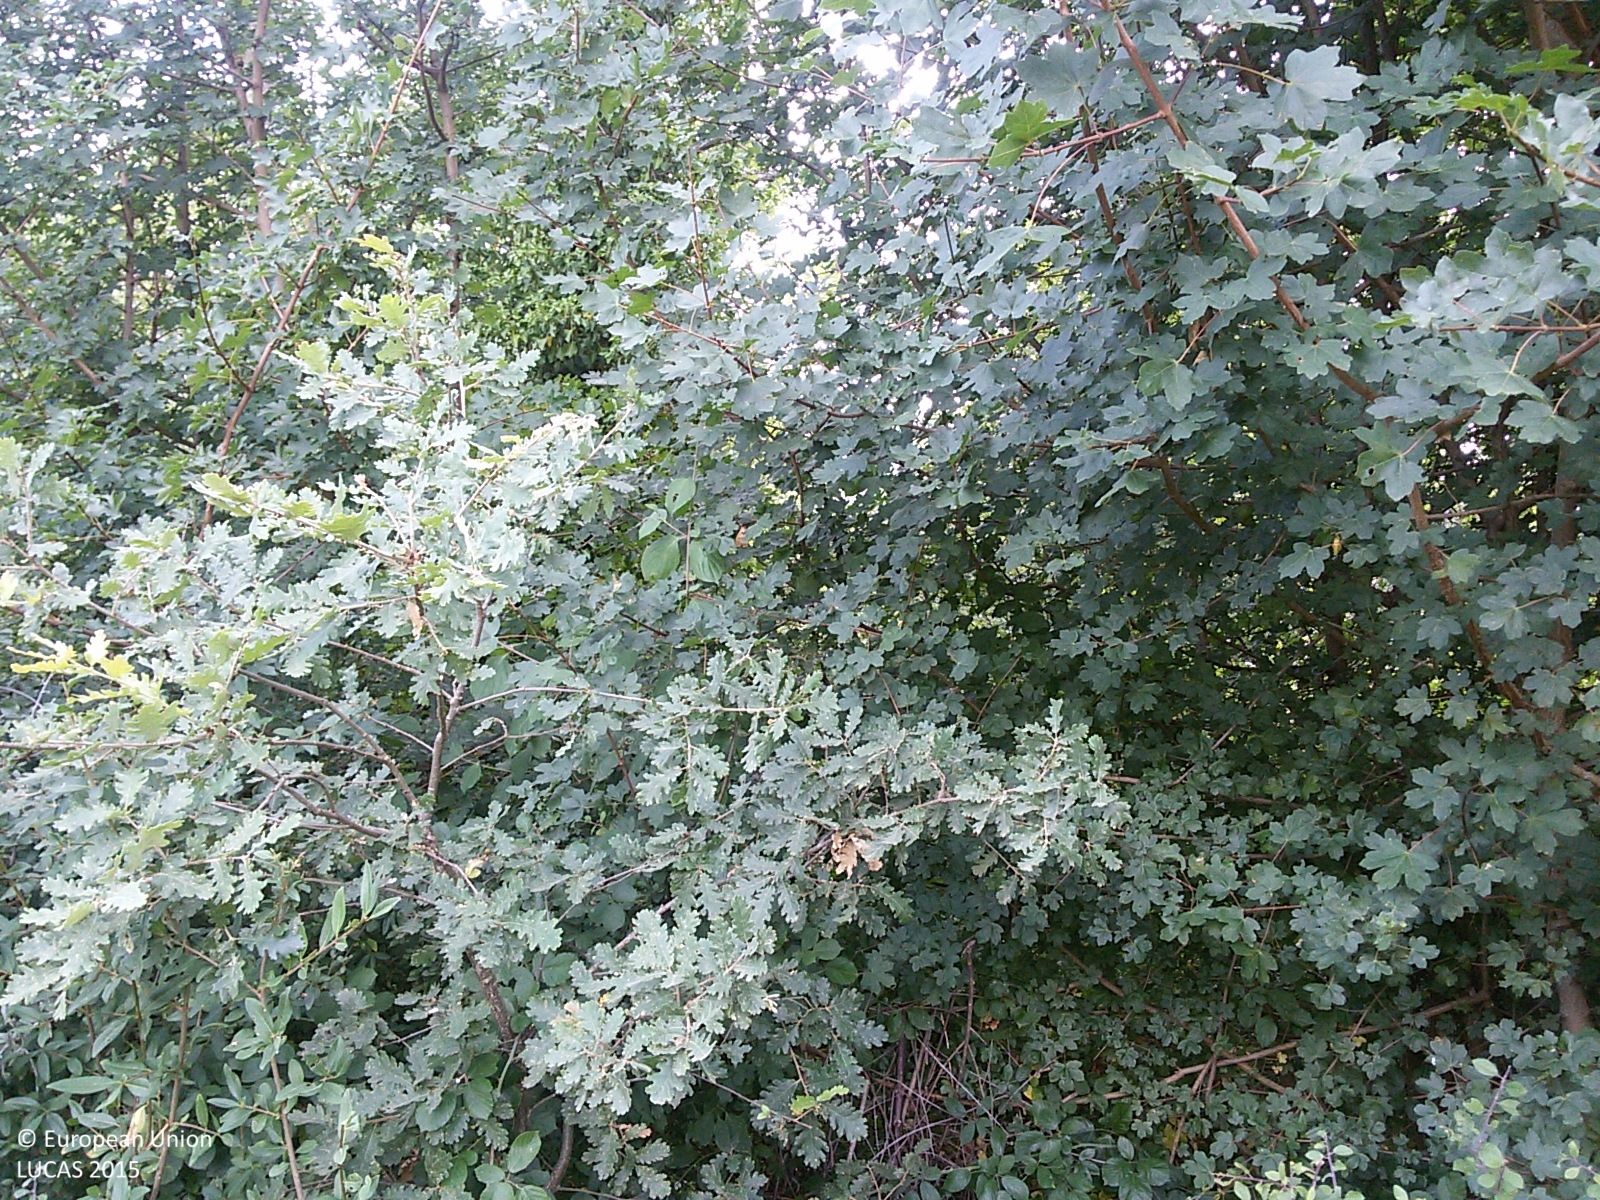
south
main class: Woodland
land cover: Broadleaved woodland
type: thermophilous deciduous forest
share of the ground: > 75 %
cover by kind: broadleaved forest trees 50 %, shrubs 30 %, herbaceous plants 10 %, consolidated bare surface 10 %
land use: Forestry
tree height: < 5 m
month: July
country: IT
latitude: 42.7878
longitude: 11.4744
